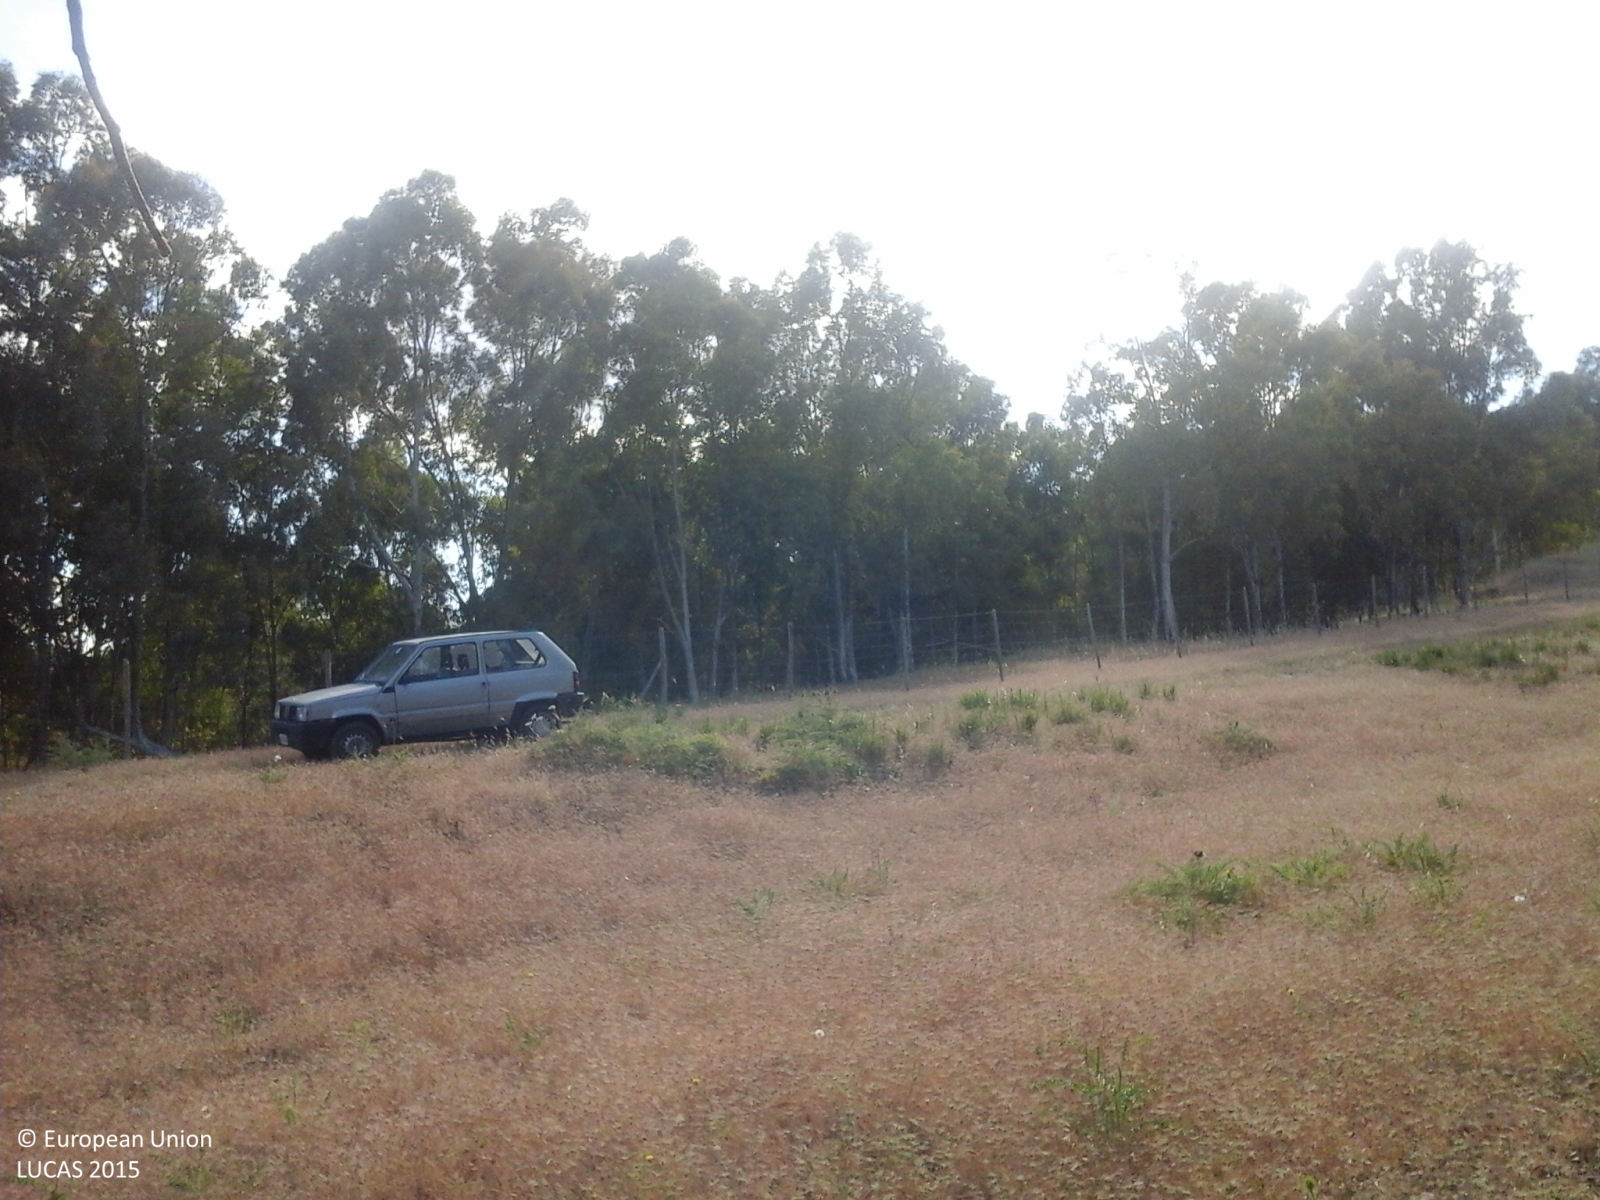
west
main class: Woodland
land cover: Broadleaved woodland
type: exotic forest
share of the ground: > 75 %
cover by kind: broadleaved forest trees 100 %
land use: Forestry
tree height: > 5 m
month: May
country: IT
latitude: 37.5672
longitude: 14.1246
